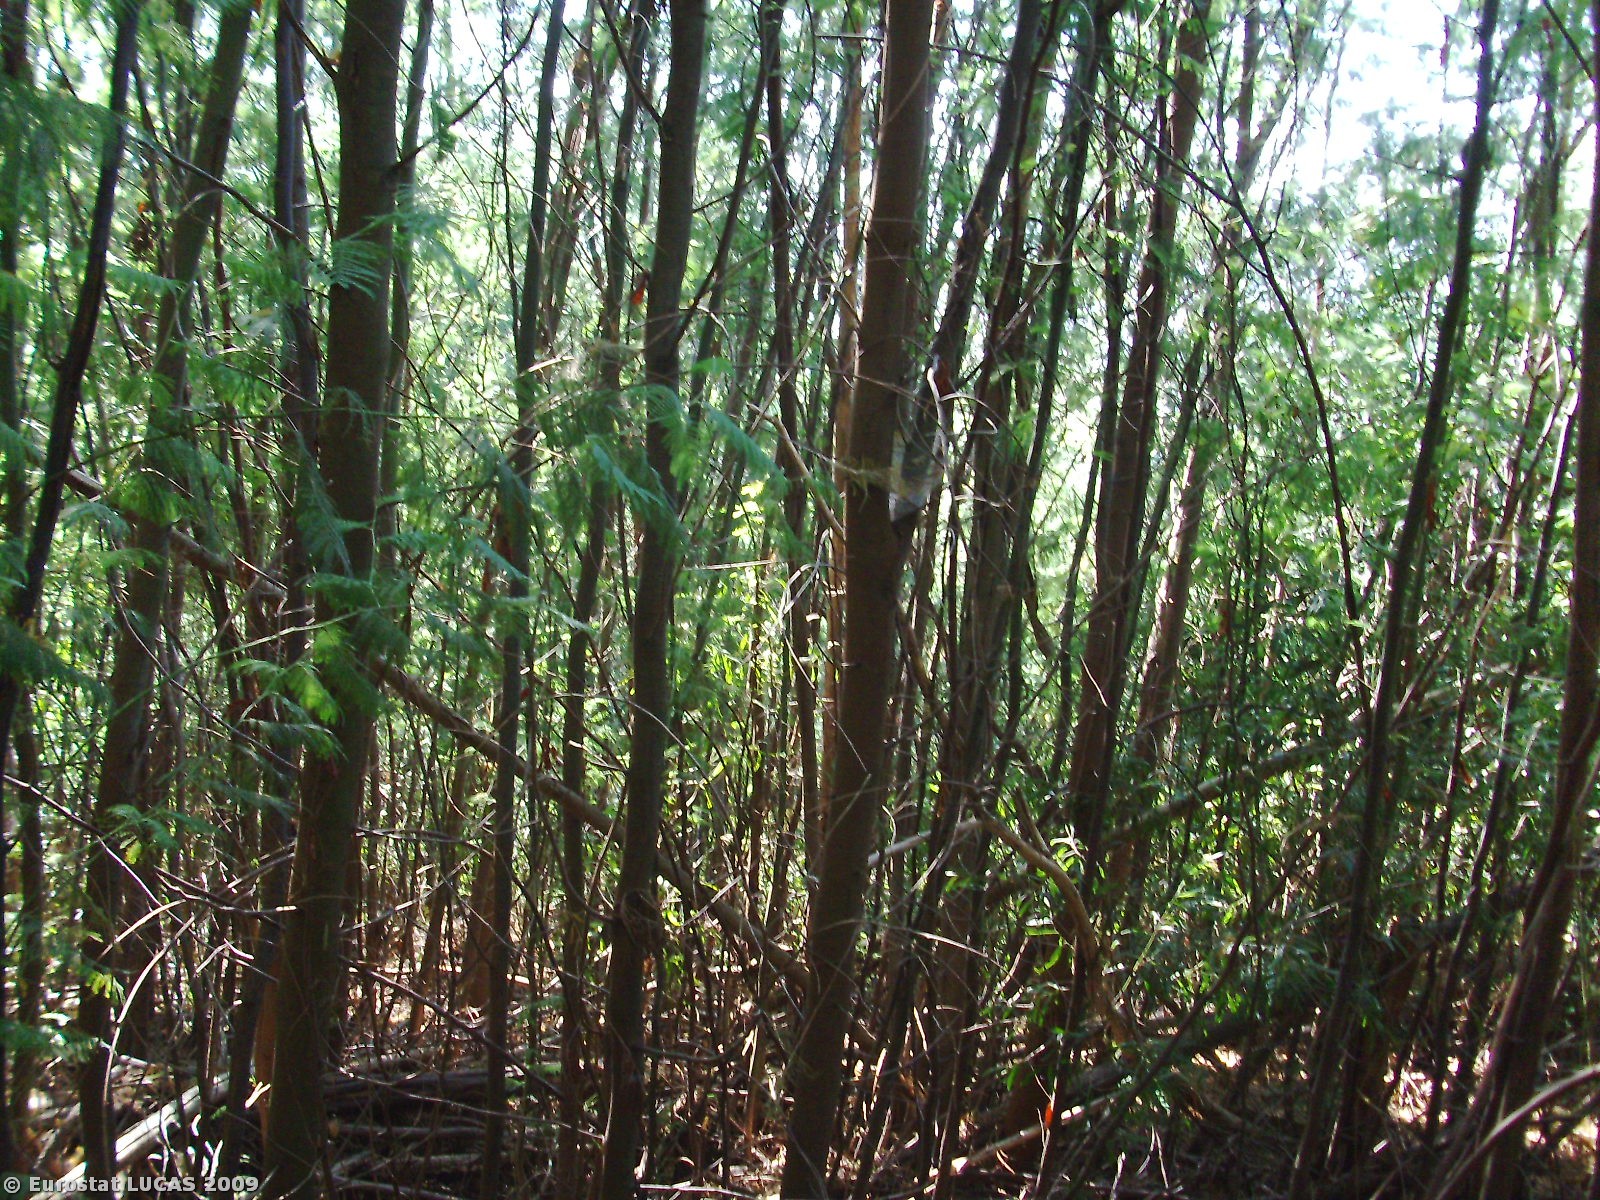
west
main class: Woodland
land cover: Broadleaved woodland
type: mesophytic deciduous forest
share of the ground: > 75 %
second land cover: Shrubland with sparse tree cover
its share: 10 - 25 %
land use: Forestry
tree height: > 5 m
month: August
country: PT
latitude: 40.1193
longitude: -8.2044
